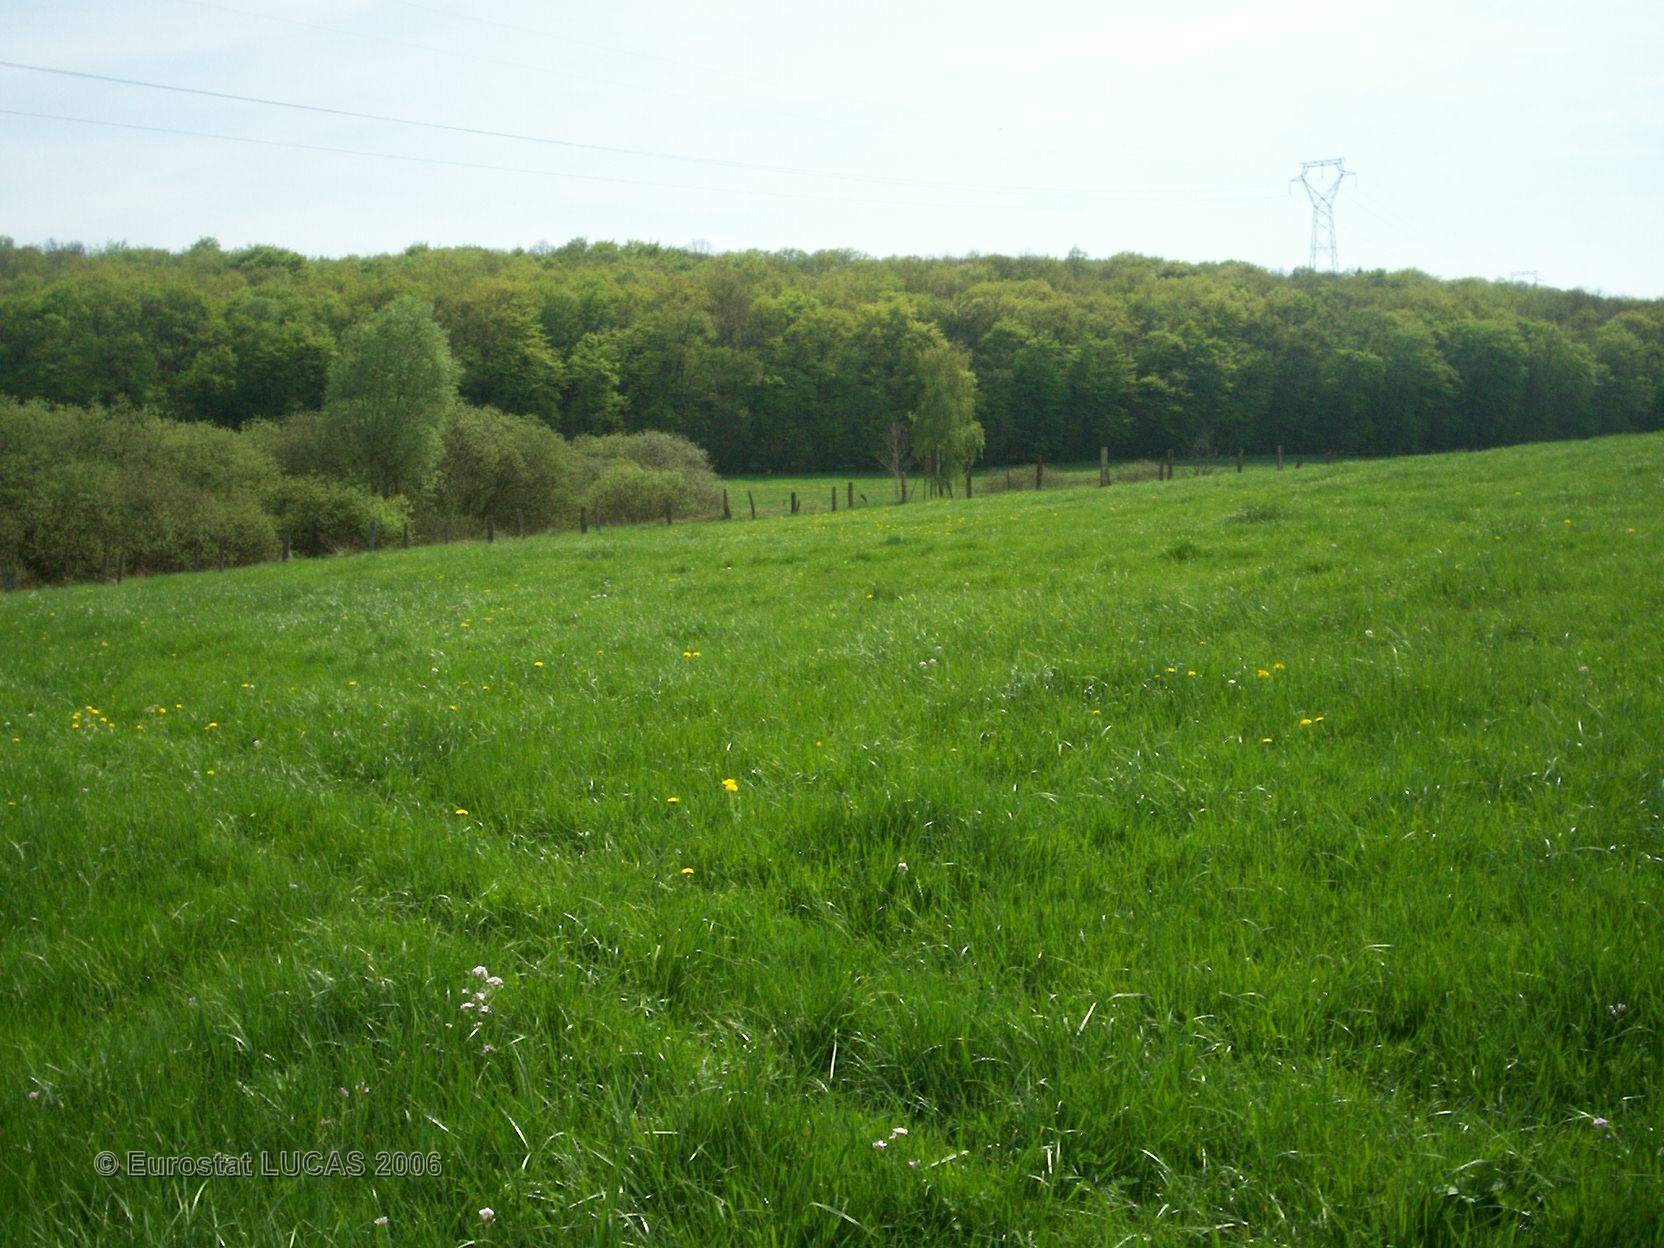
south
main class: Grassland
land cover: Grassland without tree/shrub cover
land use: Agriculture (excluding fallow land and kitchen gardens)
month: May
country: FR
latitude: 49.0650
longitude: 7.0030
